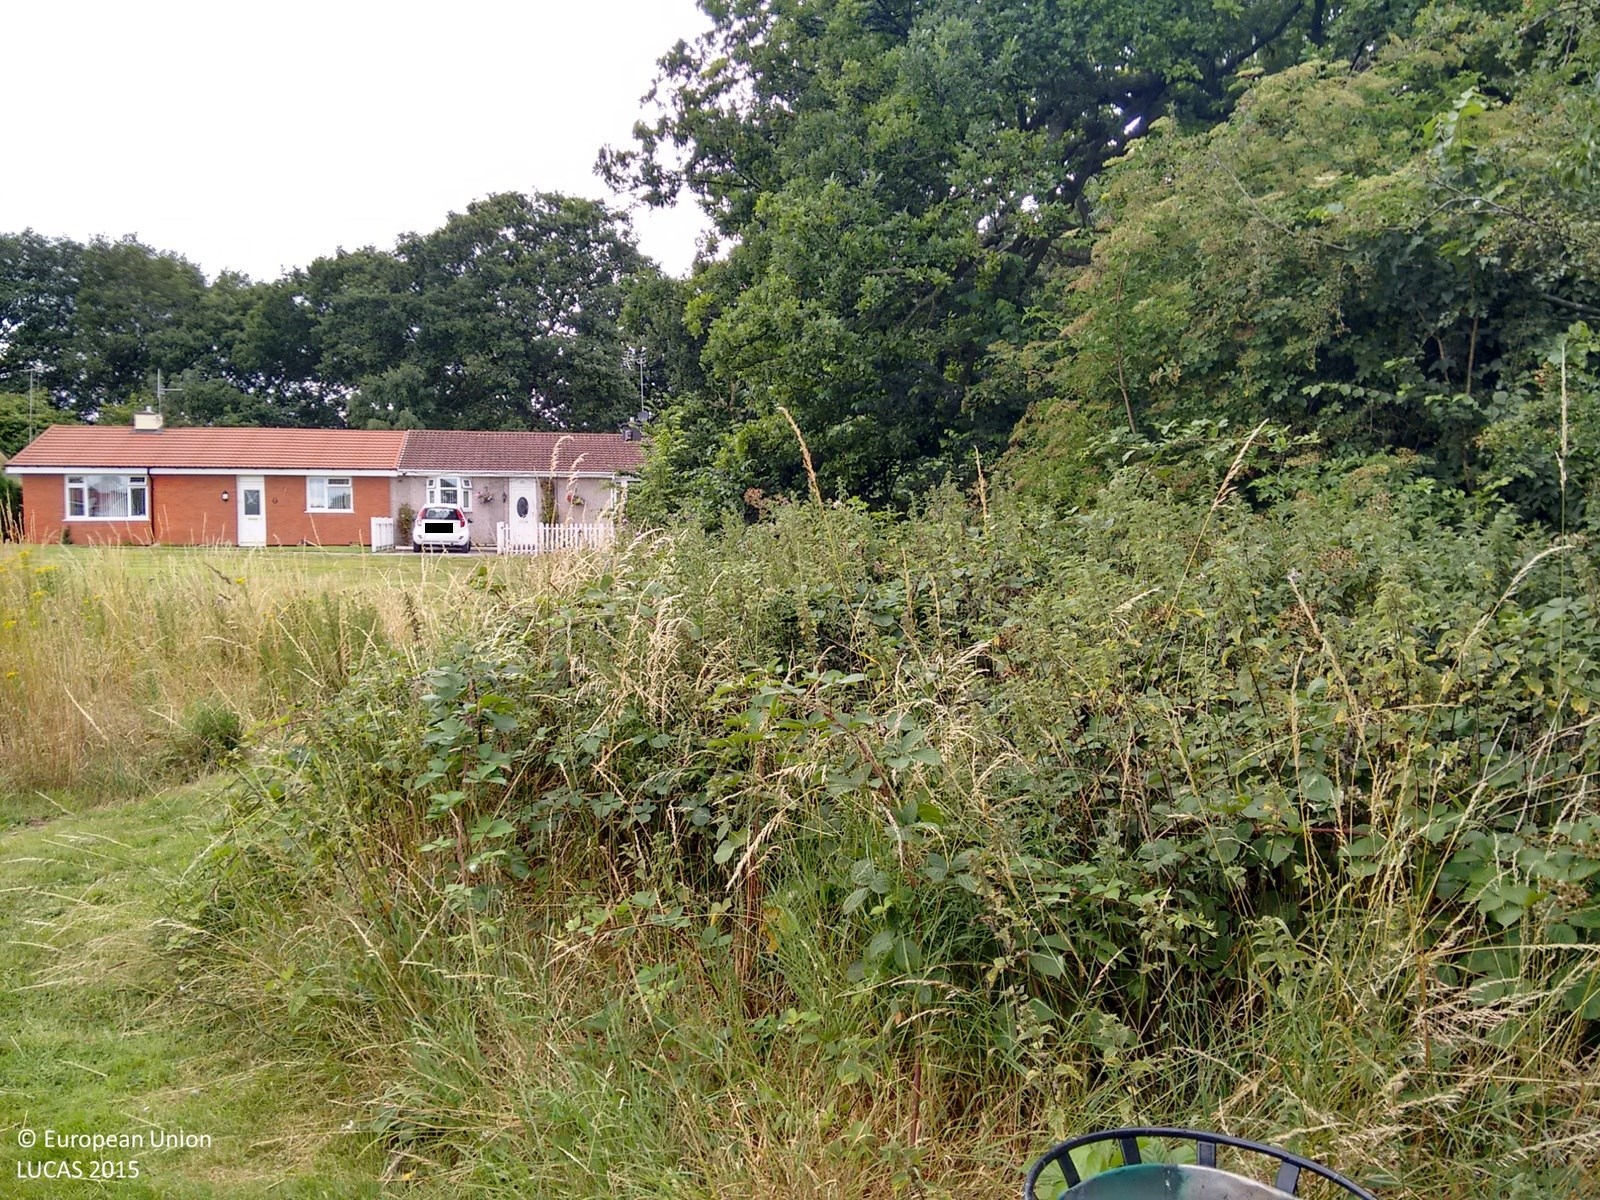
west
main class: Grassland
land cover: Grassland without tree/shrub cover
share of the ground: > 75 %
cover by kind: herbaceous plants 100 %
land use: Amenities, museums, leisure
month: July
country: GB
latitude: 53.2881
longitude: -2.9287
